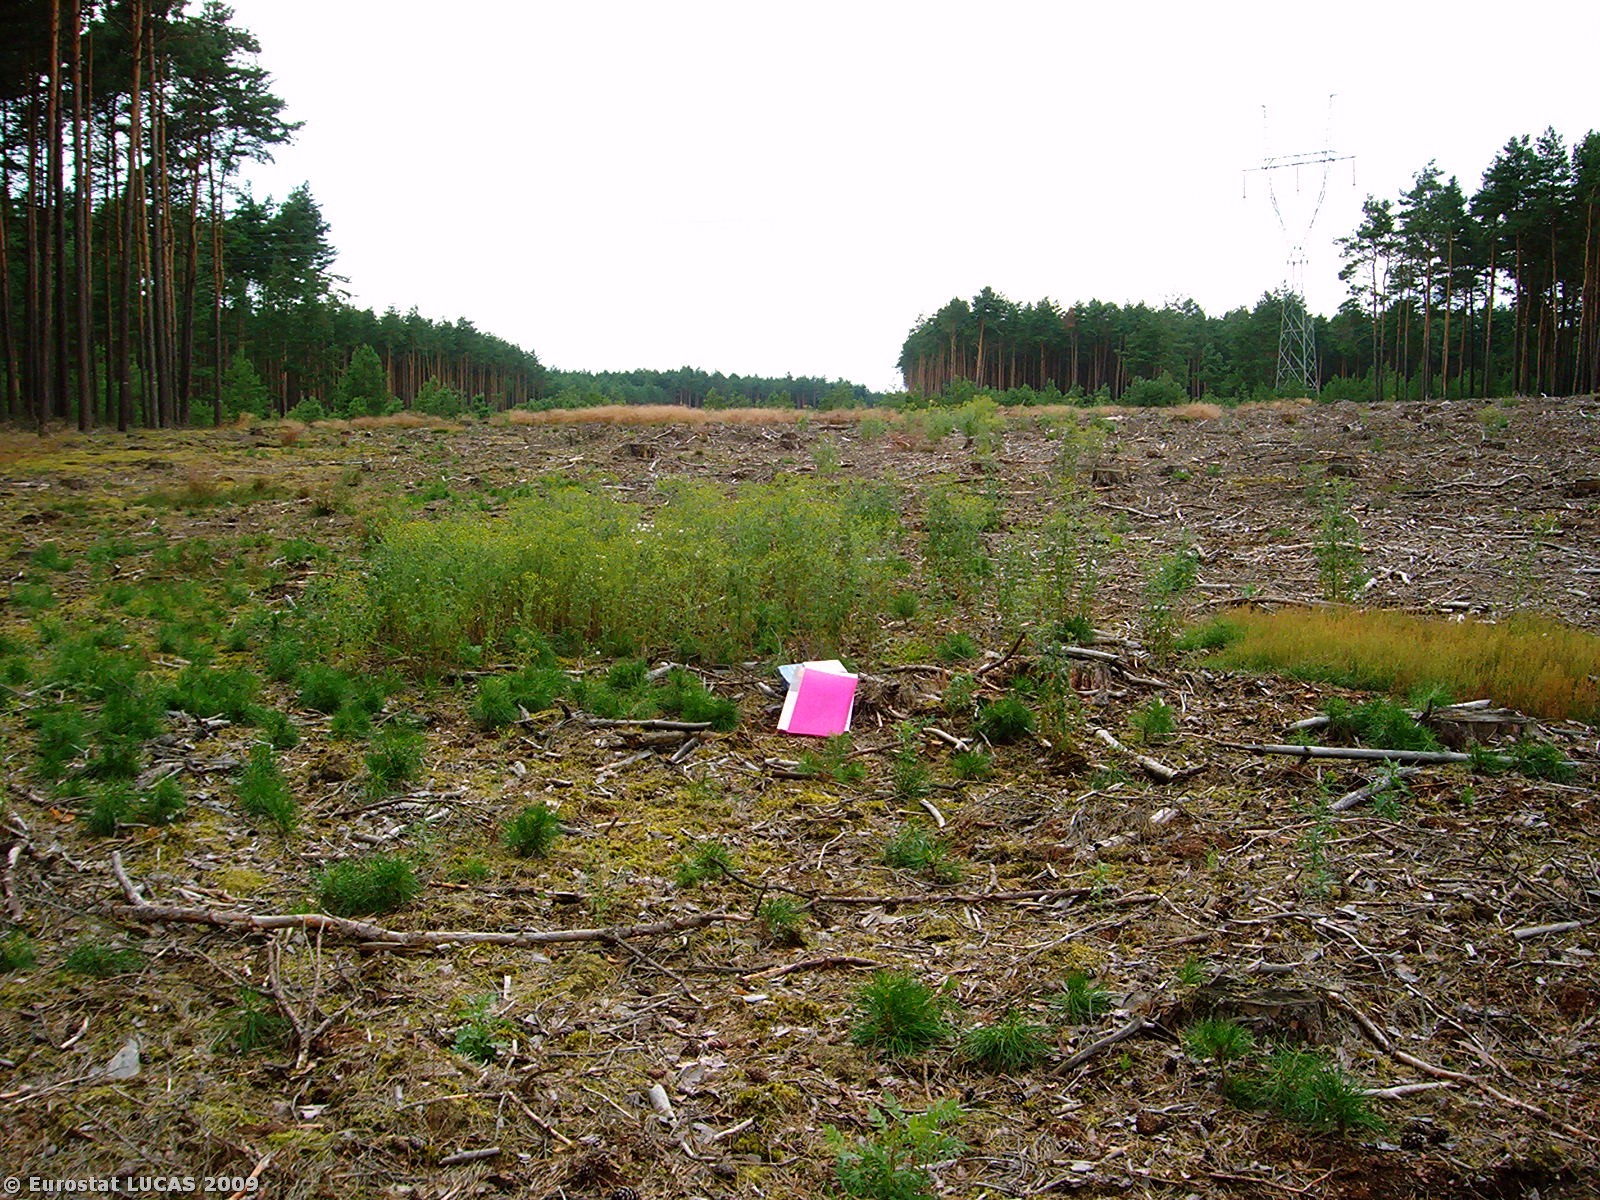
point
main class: Grassland
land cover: Spontaneously vegetated surfaces
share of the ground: 25 - 50 %
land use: Forestry
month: July
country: PL
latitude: 52.6152
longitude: 15.3944
